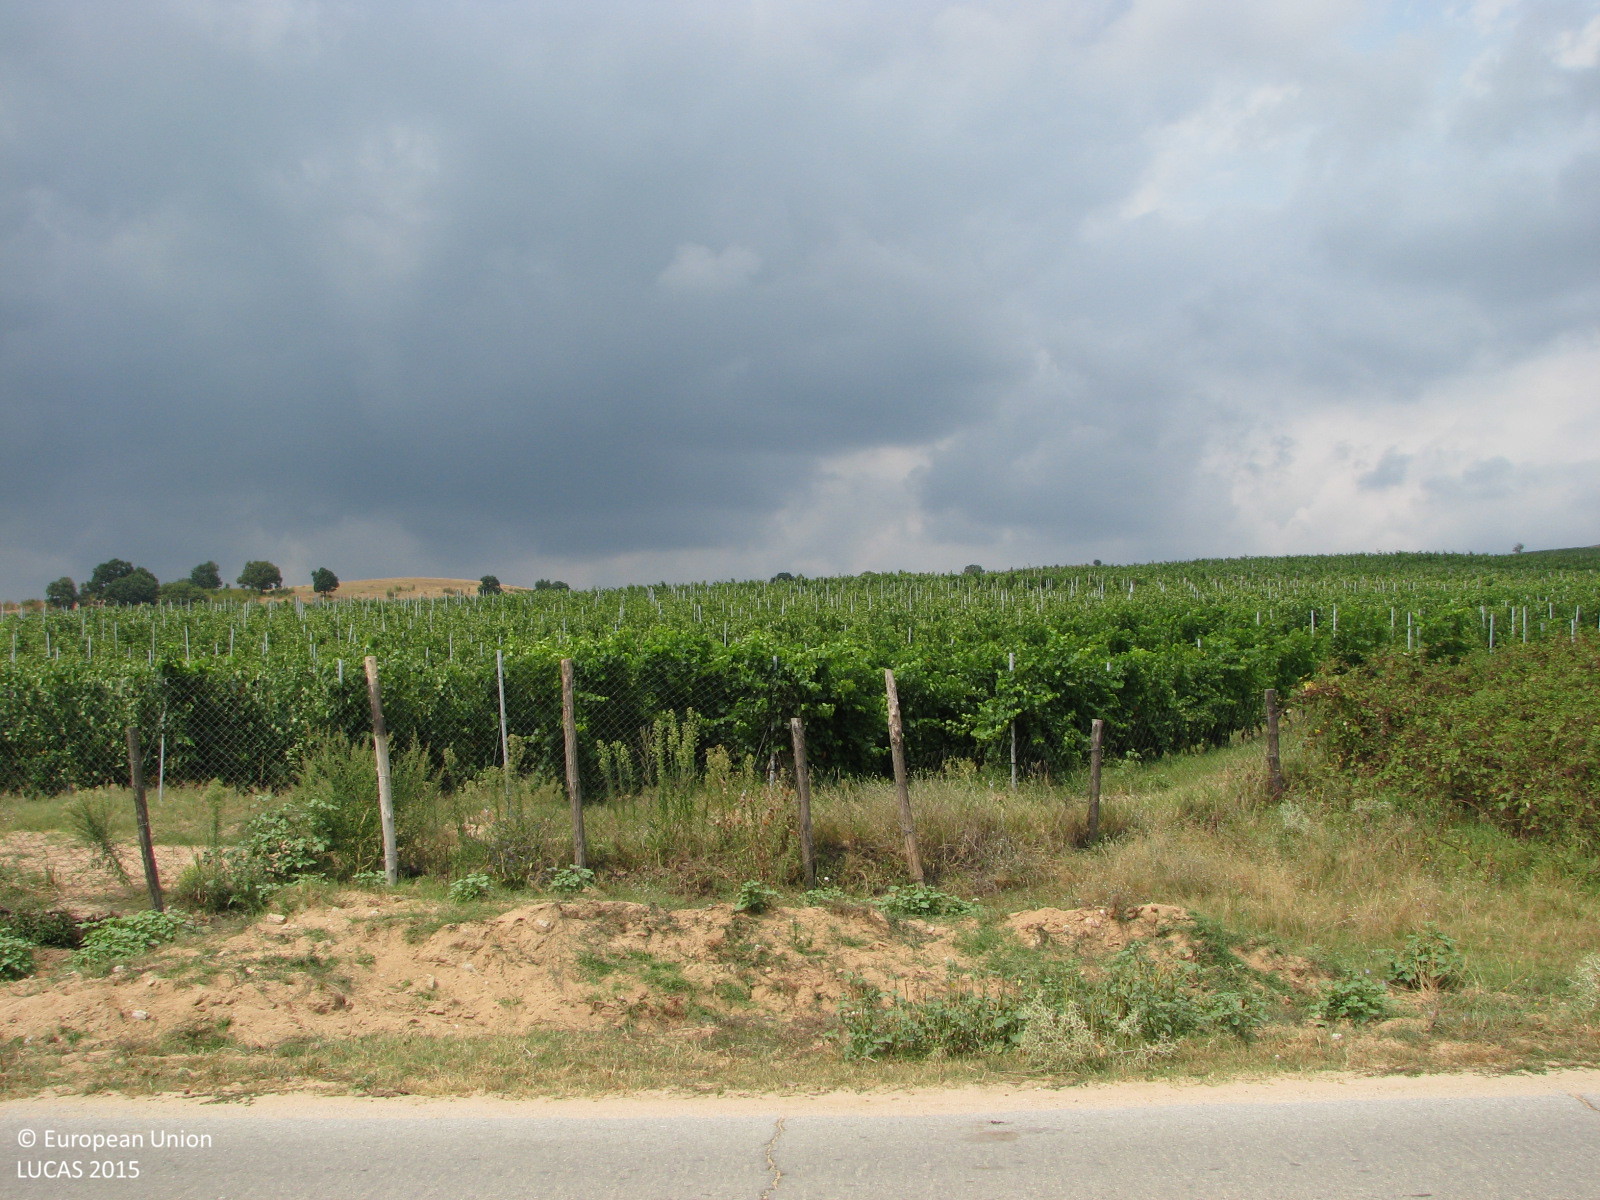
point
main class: Cropland
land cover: Vineyards
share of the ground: 50 - 75 %
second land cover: Spontaneously vegetated surfaces
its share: 50 - 75 %
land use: Agriculture (excluding fallow land and kitchen gardens)
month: August
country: BG
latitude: 42.6191
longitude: 26.0172
